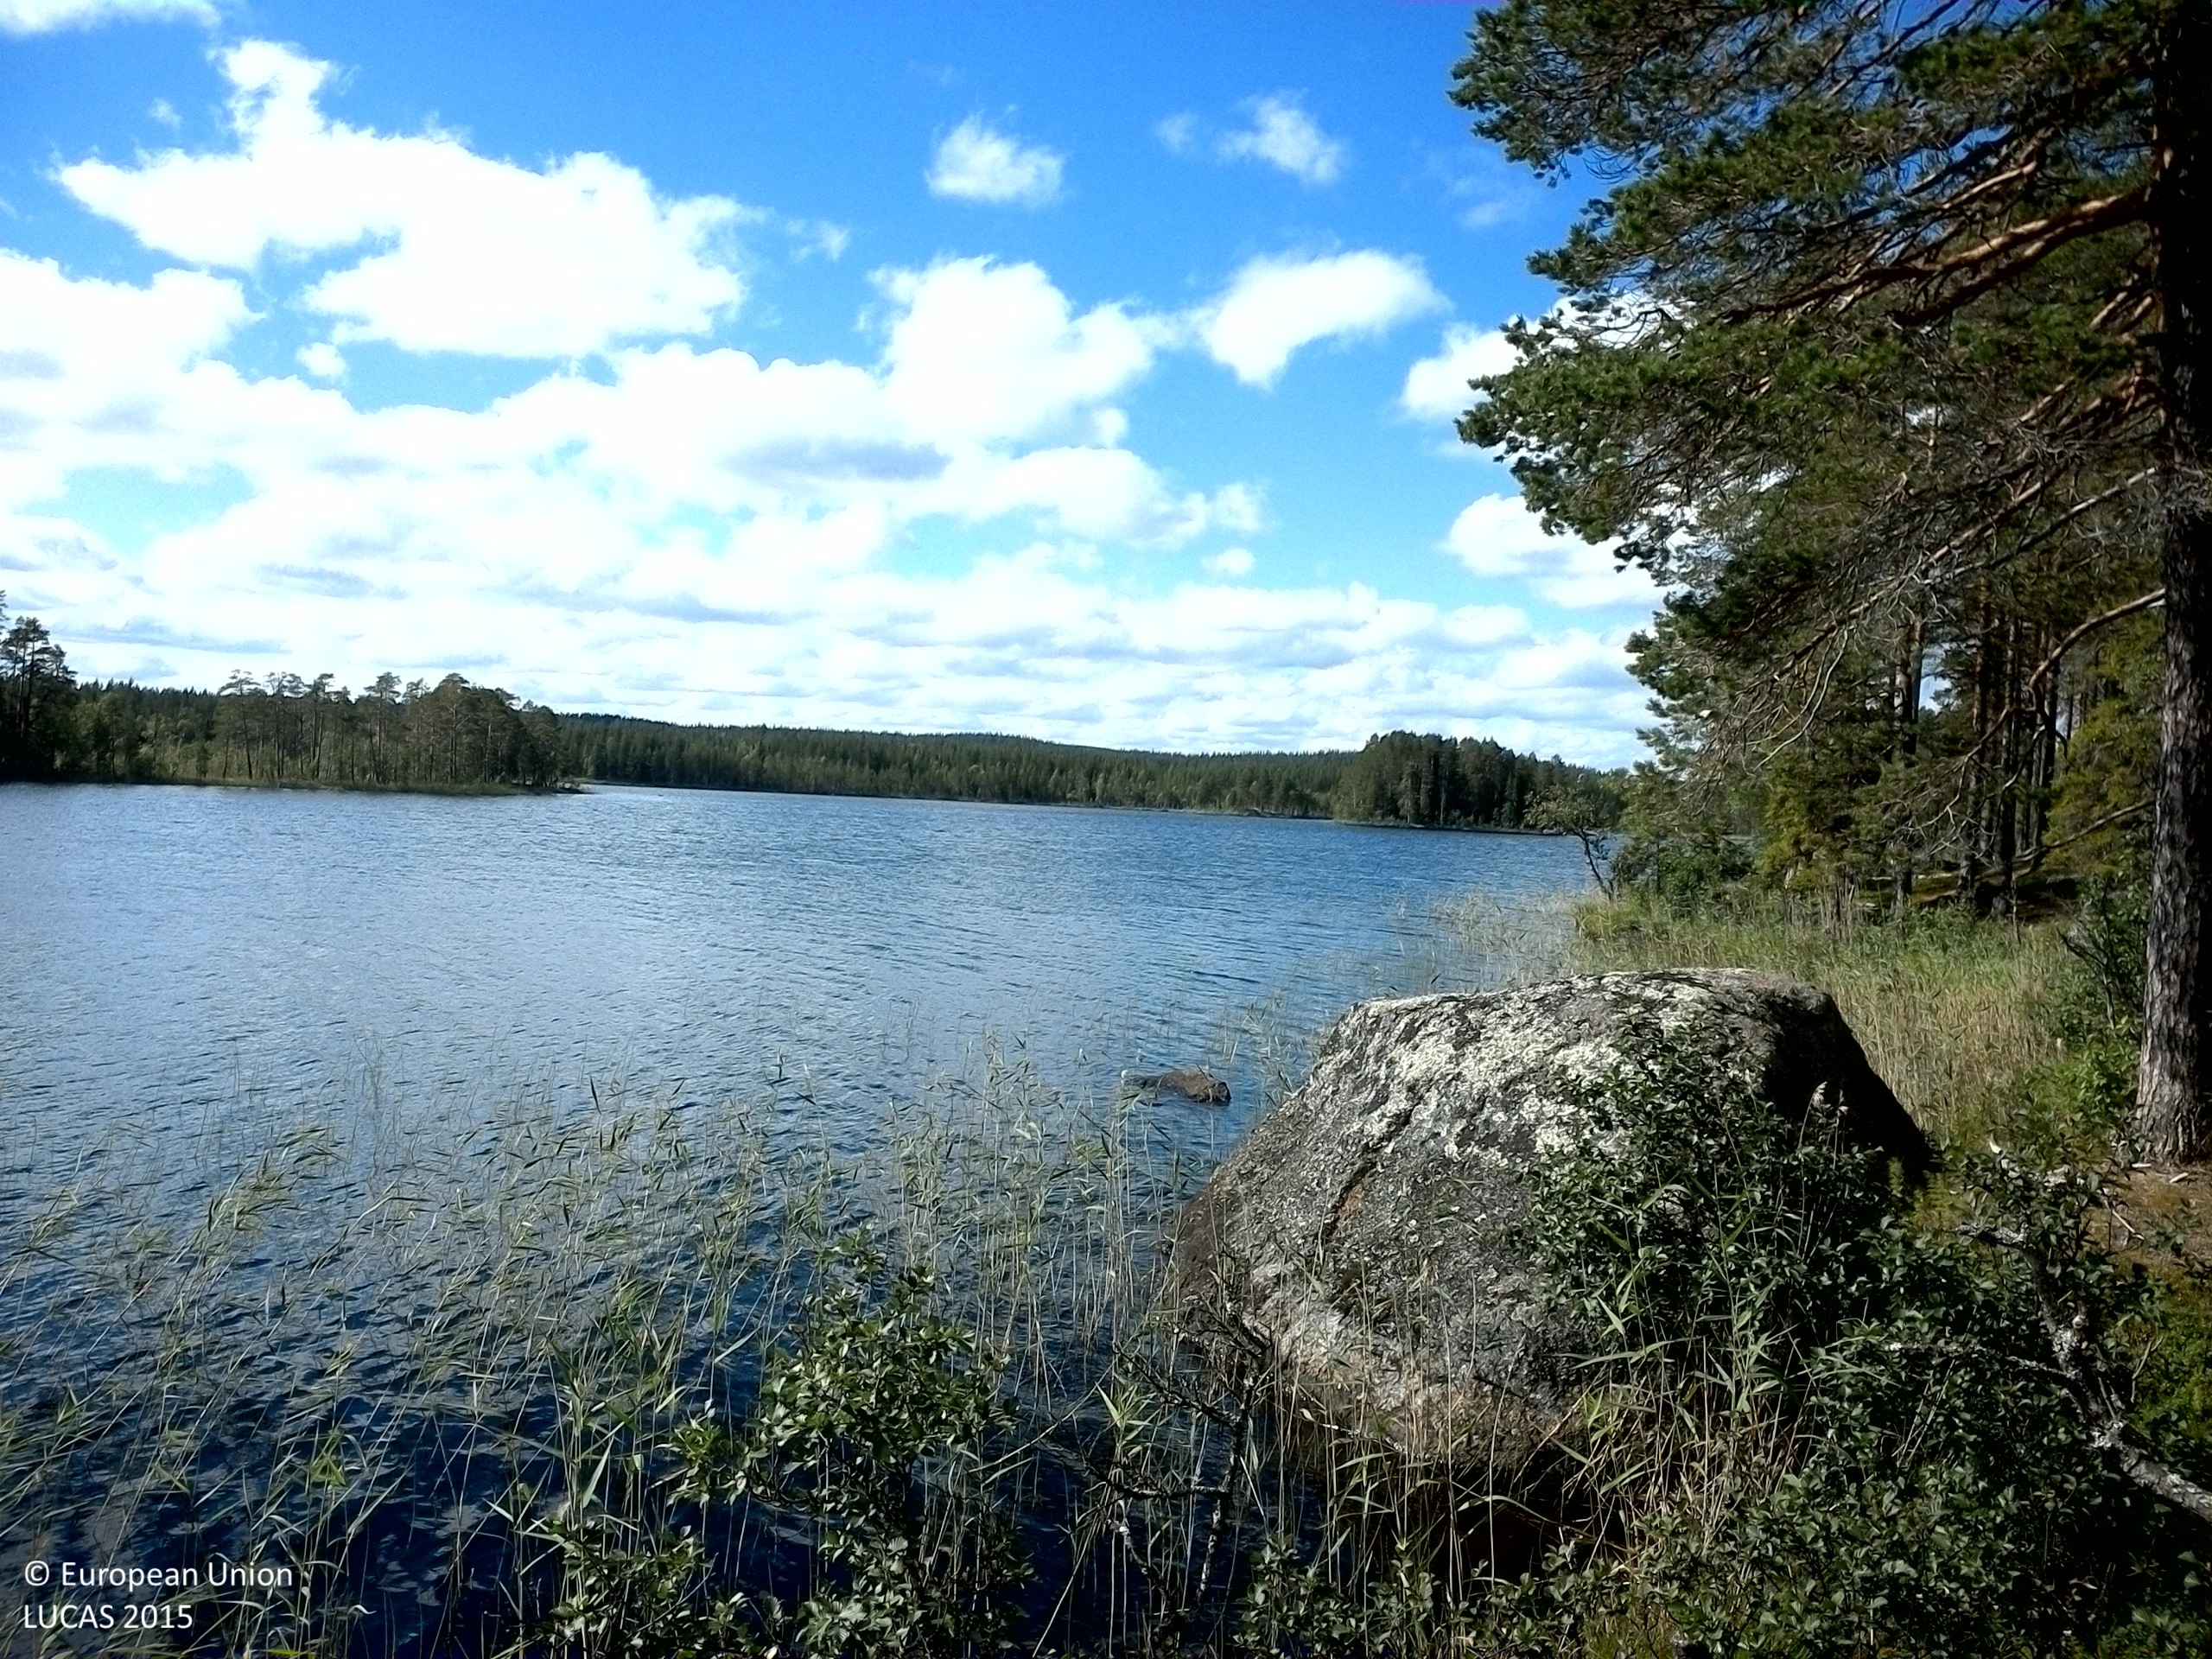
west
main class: Woodland
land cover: Pine dominated coniferous woodland
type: boreal forest
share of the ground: 25 - 50 %
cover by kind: shrubs 40 %, coniferous forest trees 35 %, lichens and mosses 25 %
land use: Forestry
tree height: > 5 m
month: August
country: SE
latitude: 64.0521
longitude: 17.6109
